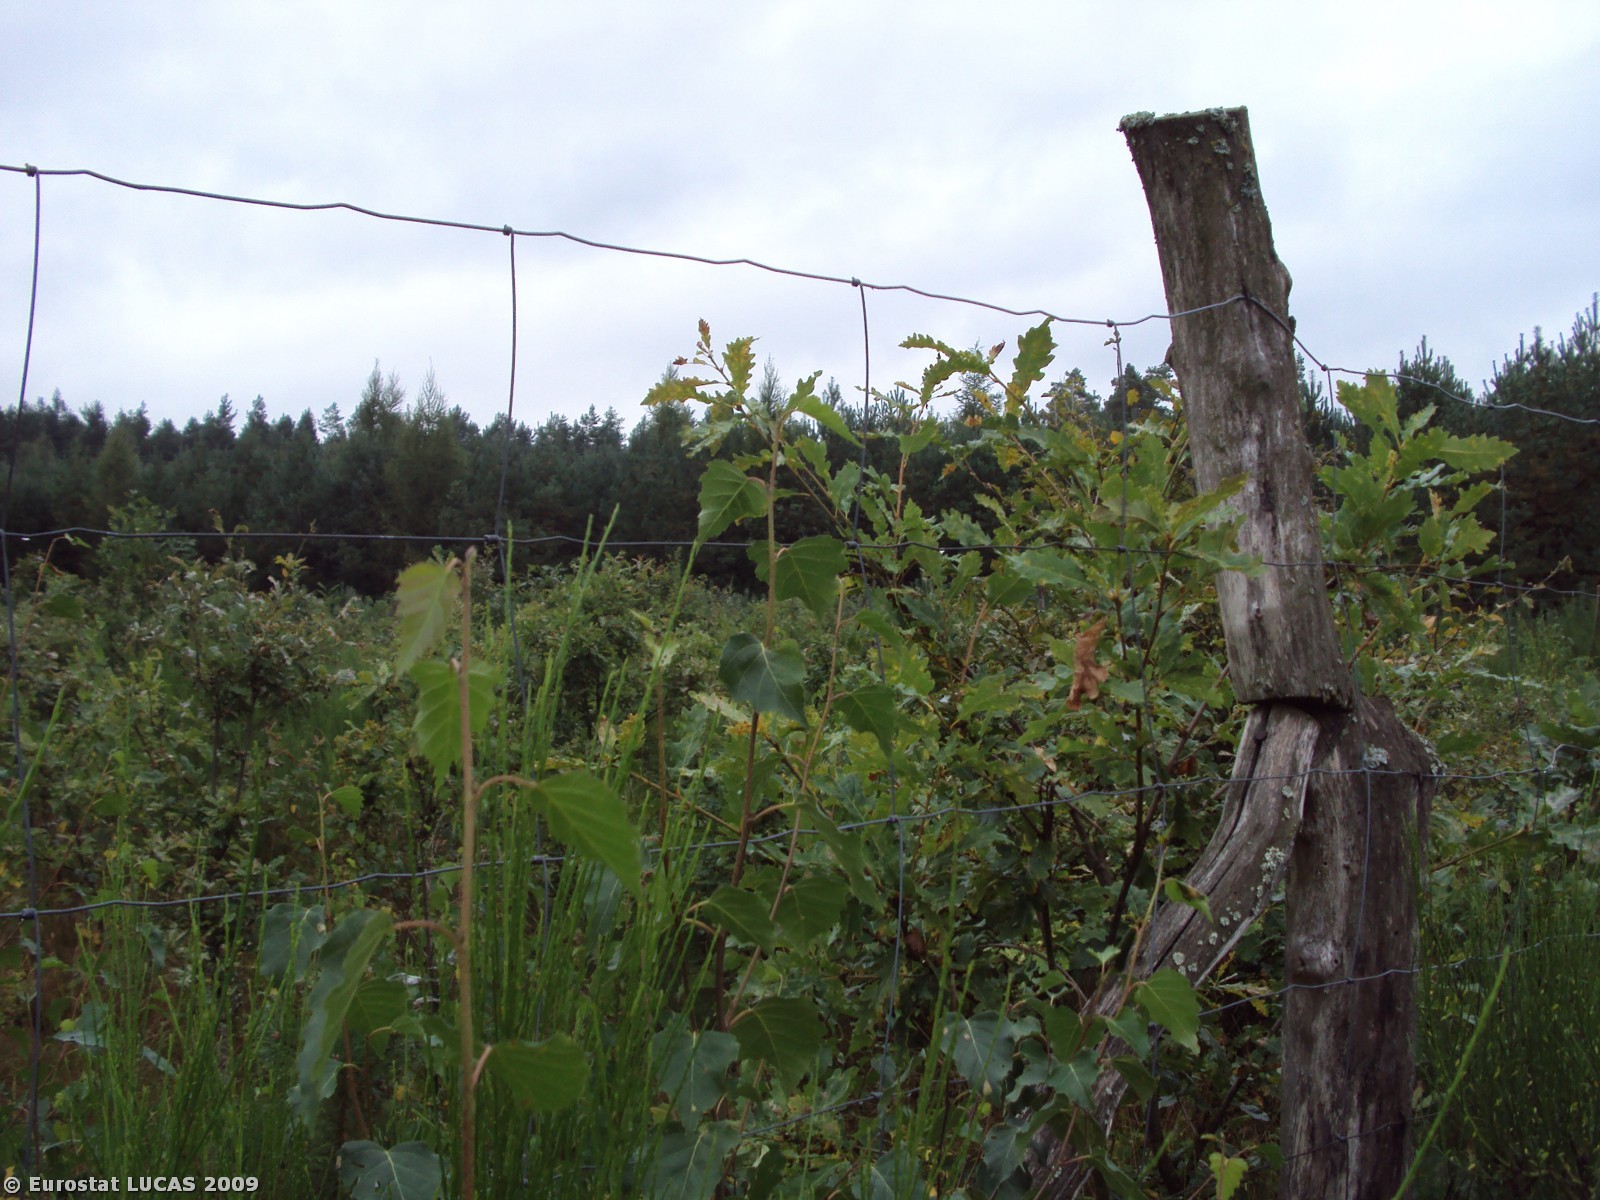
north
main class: Woodland
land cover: Broadleaved woodland
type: mesophytic deciduous forest
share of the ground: > 75 %
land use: Forestry
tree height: > 5 m
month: September
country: PL
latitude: 53.5642
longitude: 15.9080
